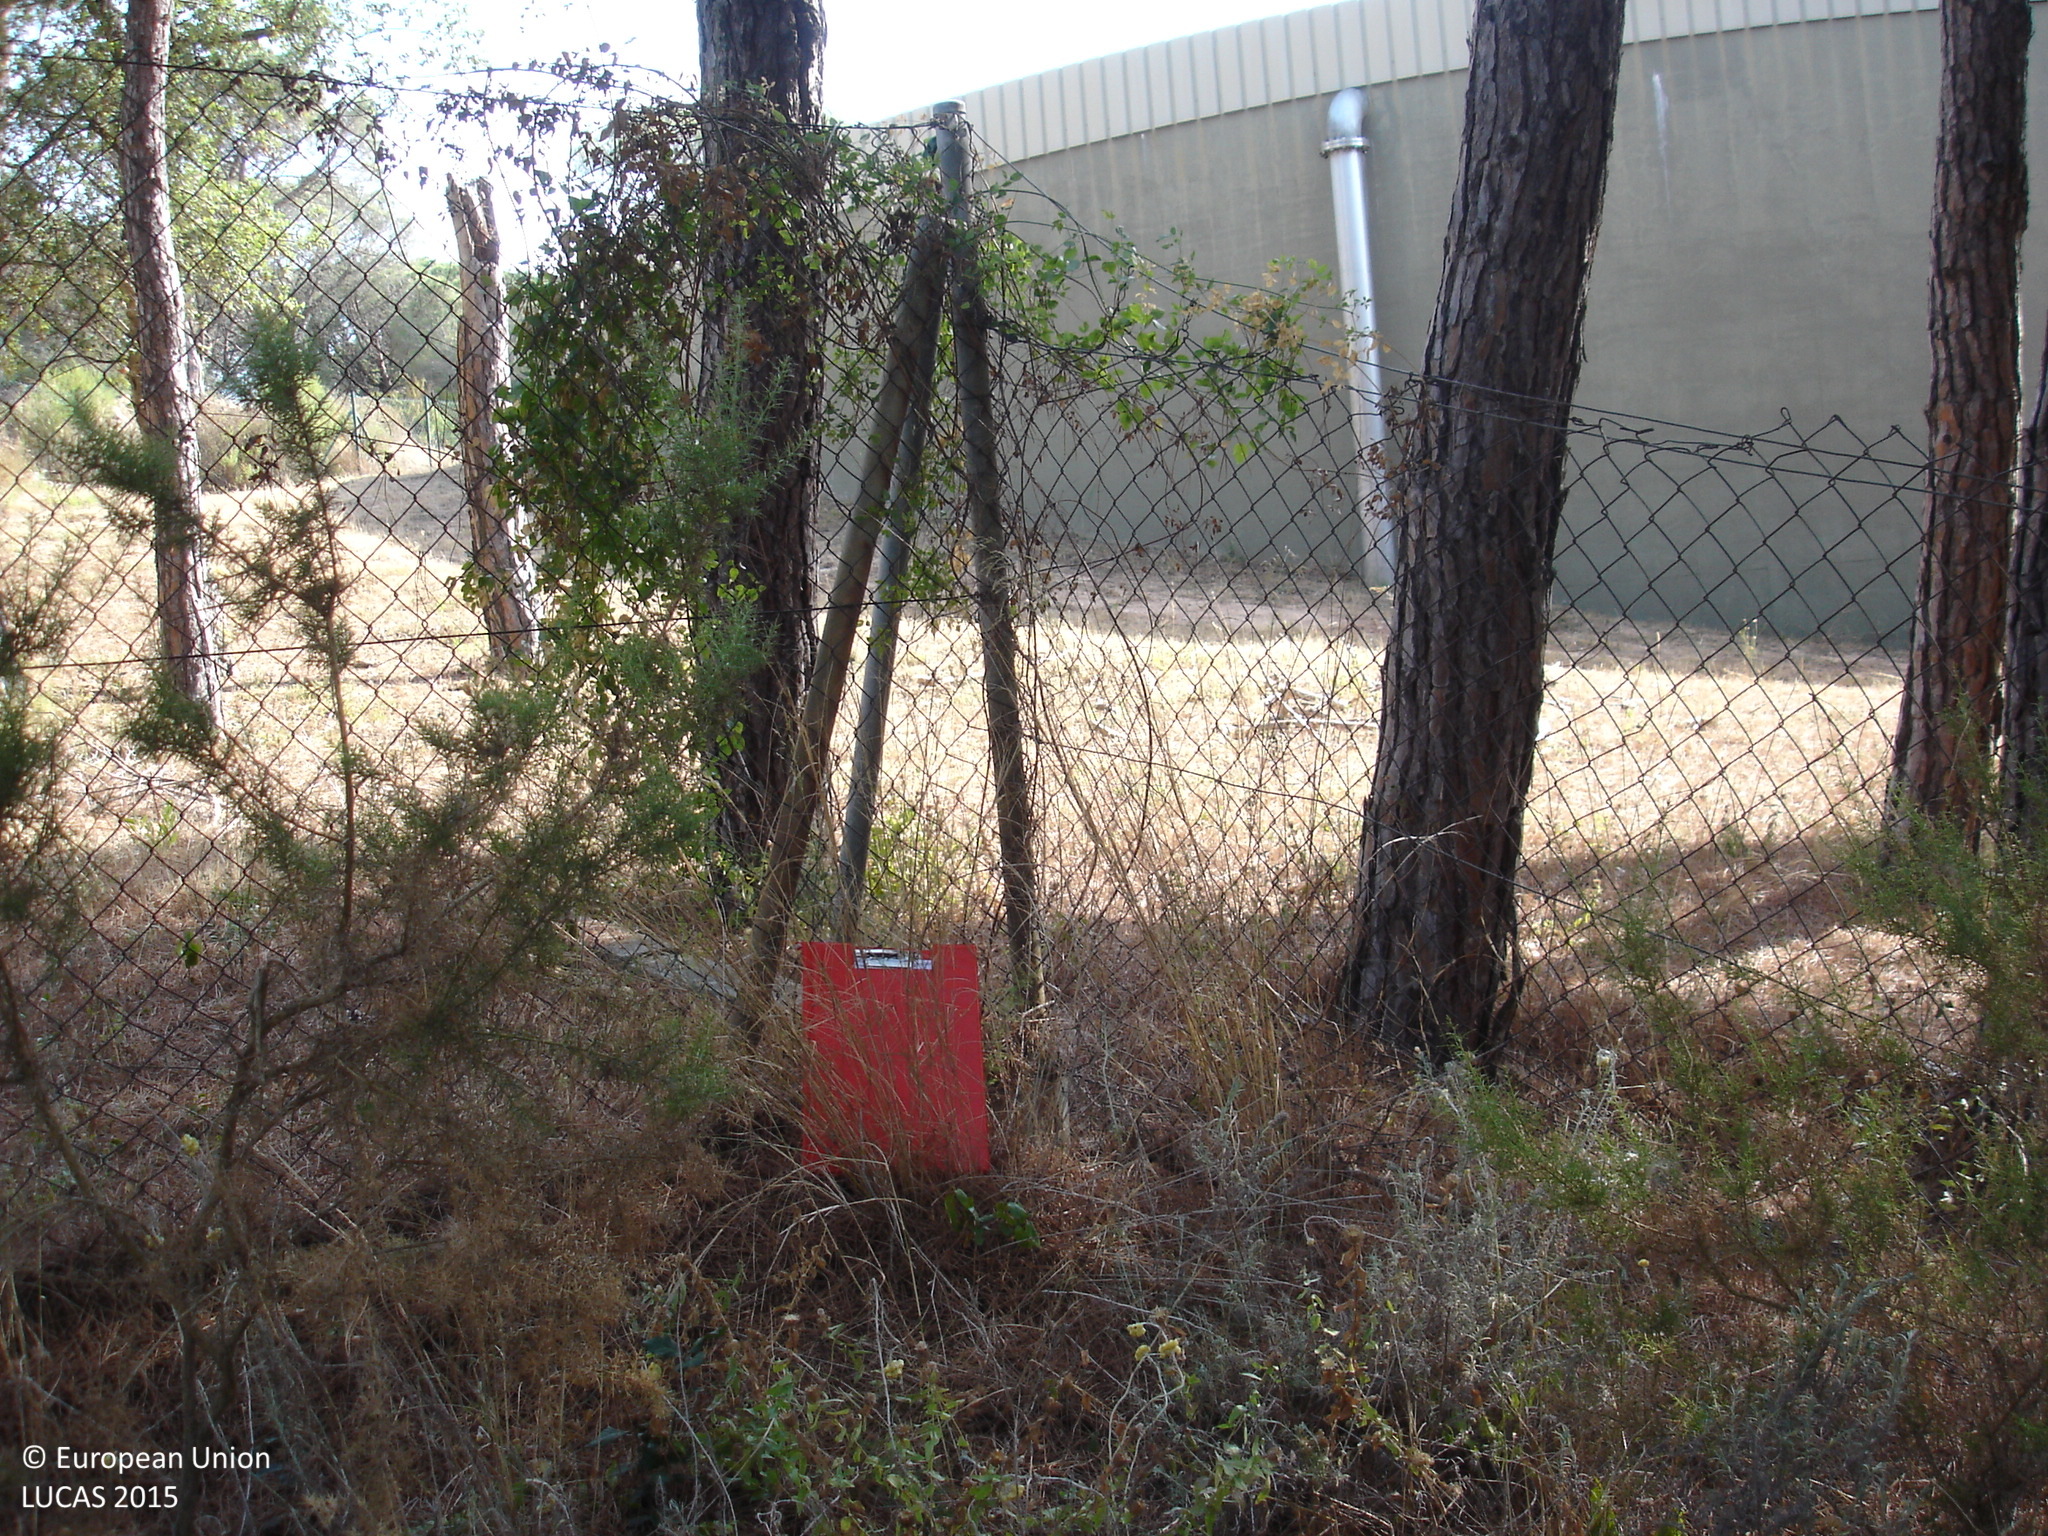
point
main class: Woodland
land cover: Pine dominated coniferous woodland
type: coniferous forest of the mediterranean region
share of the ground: 50 - 75 %
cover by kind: coniferous forest trees 70 %, herbaceous plants 25 %, broadleaved forest trees 5 %
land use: Forestry
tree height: > 5 m
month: July
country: ES
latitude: 41.7971
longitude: 3.0247
